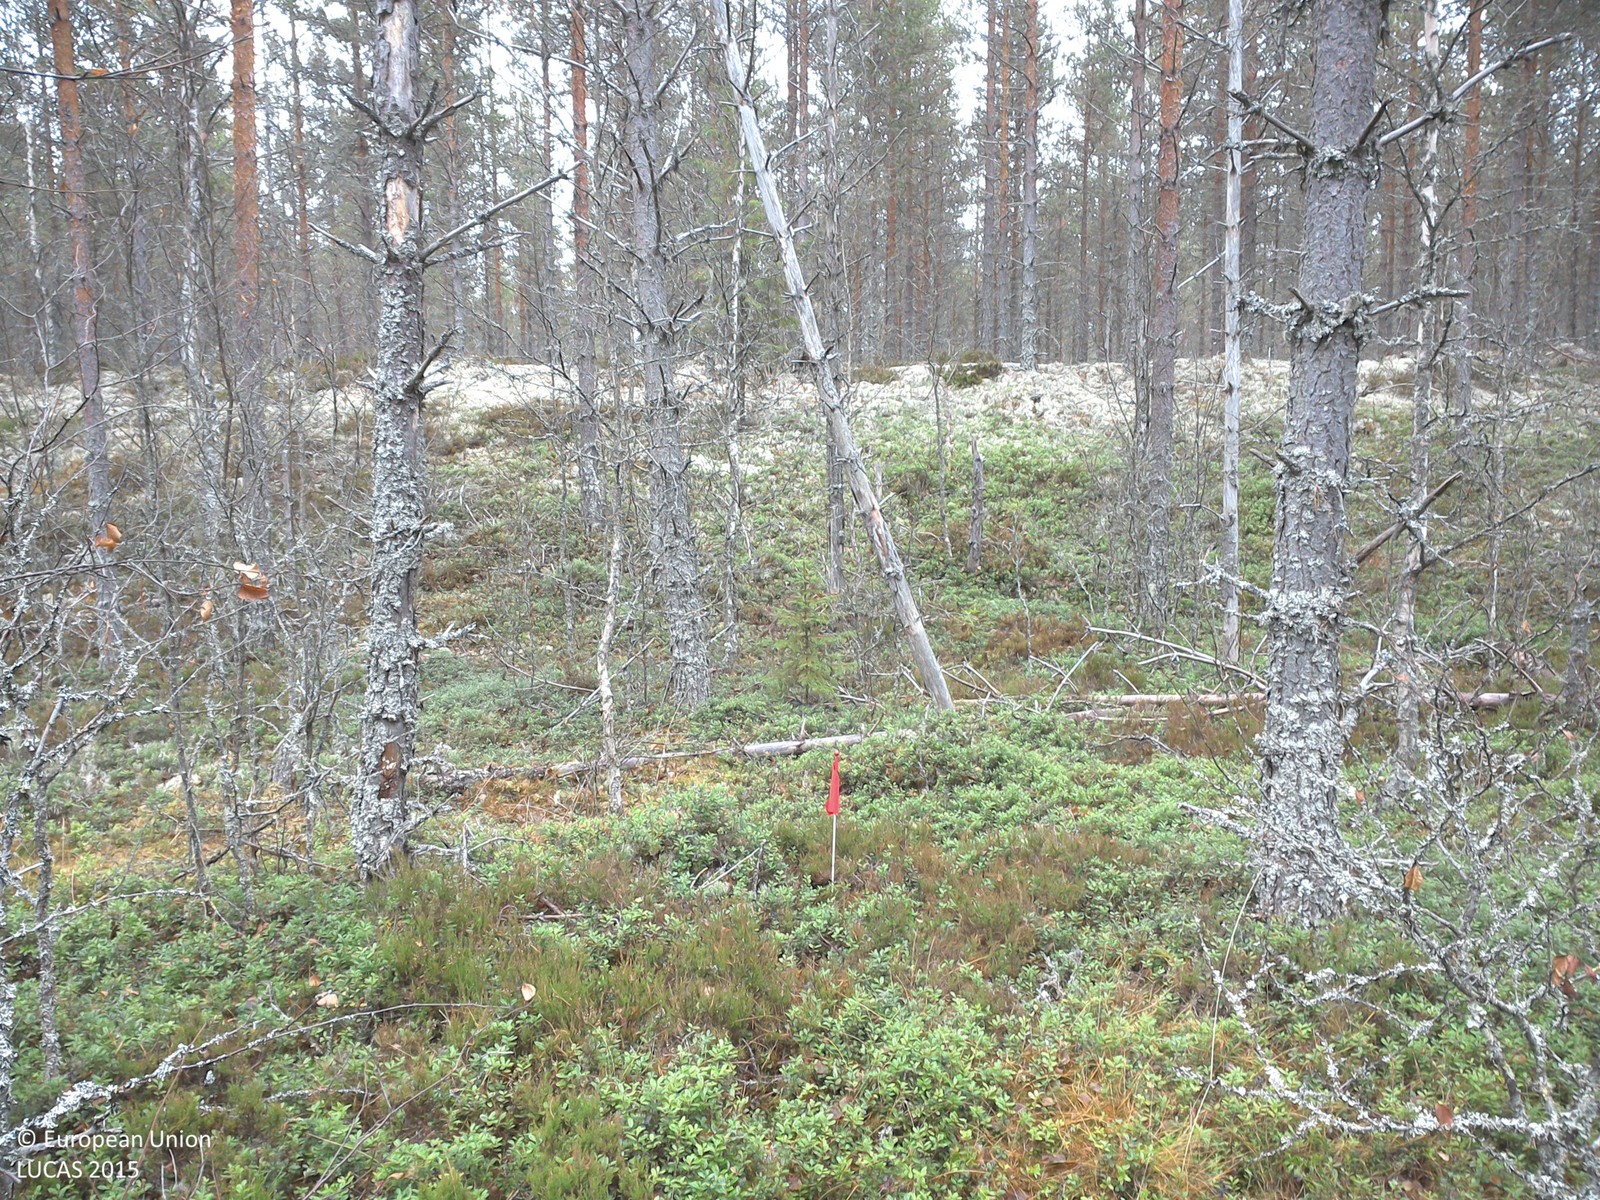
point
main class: Woodland
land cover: Pine dominated coniferous woodland
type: boreal forest
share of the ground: > 75 %
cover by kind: coniferous forest trees 65 %, shrubs 20 %, broadleaved forest trees 15 %
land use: Forestry
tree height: > 5 m
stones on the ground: < 10 %
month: November
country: SE
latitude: 60.1726
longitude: 14.1890
